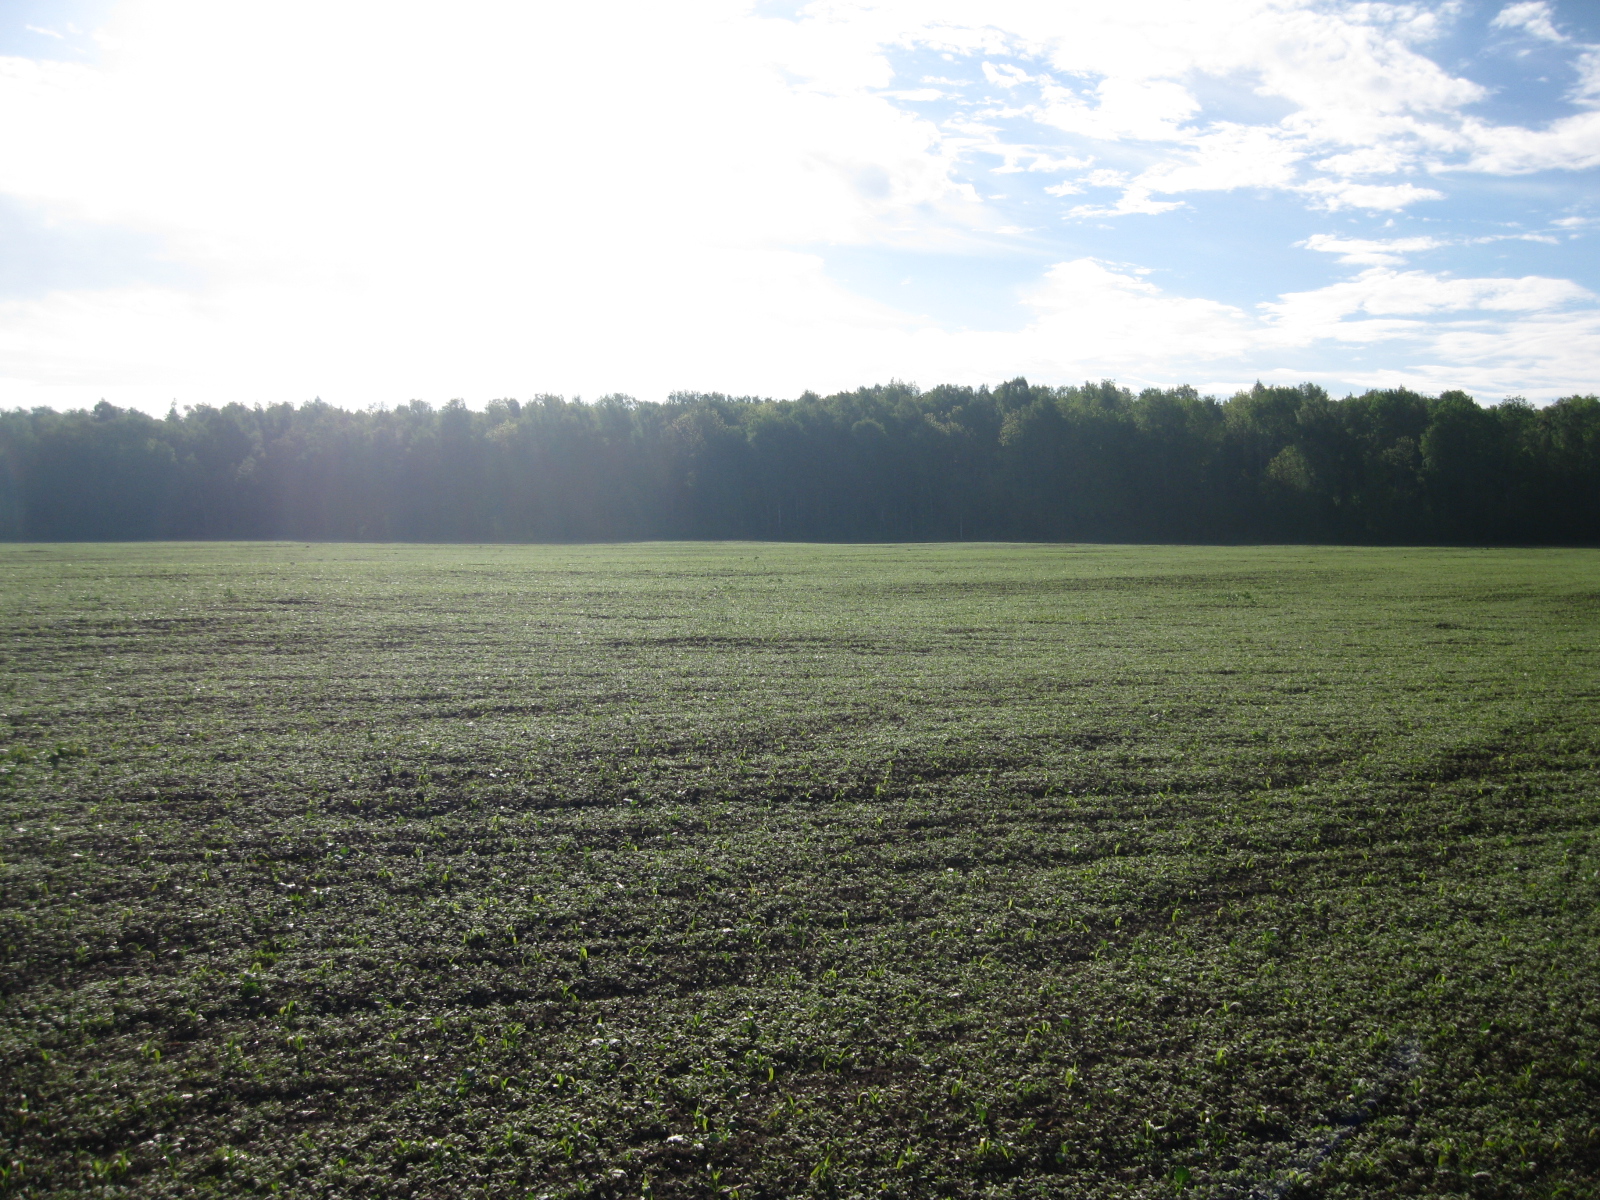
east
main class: Cropland
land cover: Maize
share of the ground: 25 - 50 %
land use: Agriculture (excluding fallow land and kitchen gardens)
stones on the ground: < 10 %
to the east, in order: Maize
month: May
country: LT
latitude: 56.1659
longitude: 24.4777
